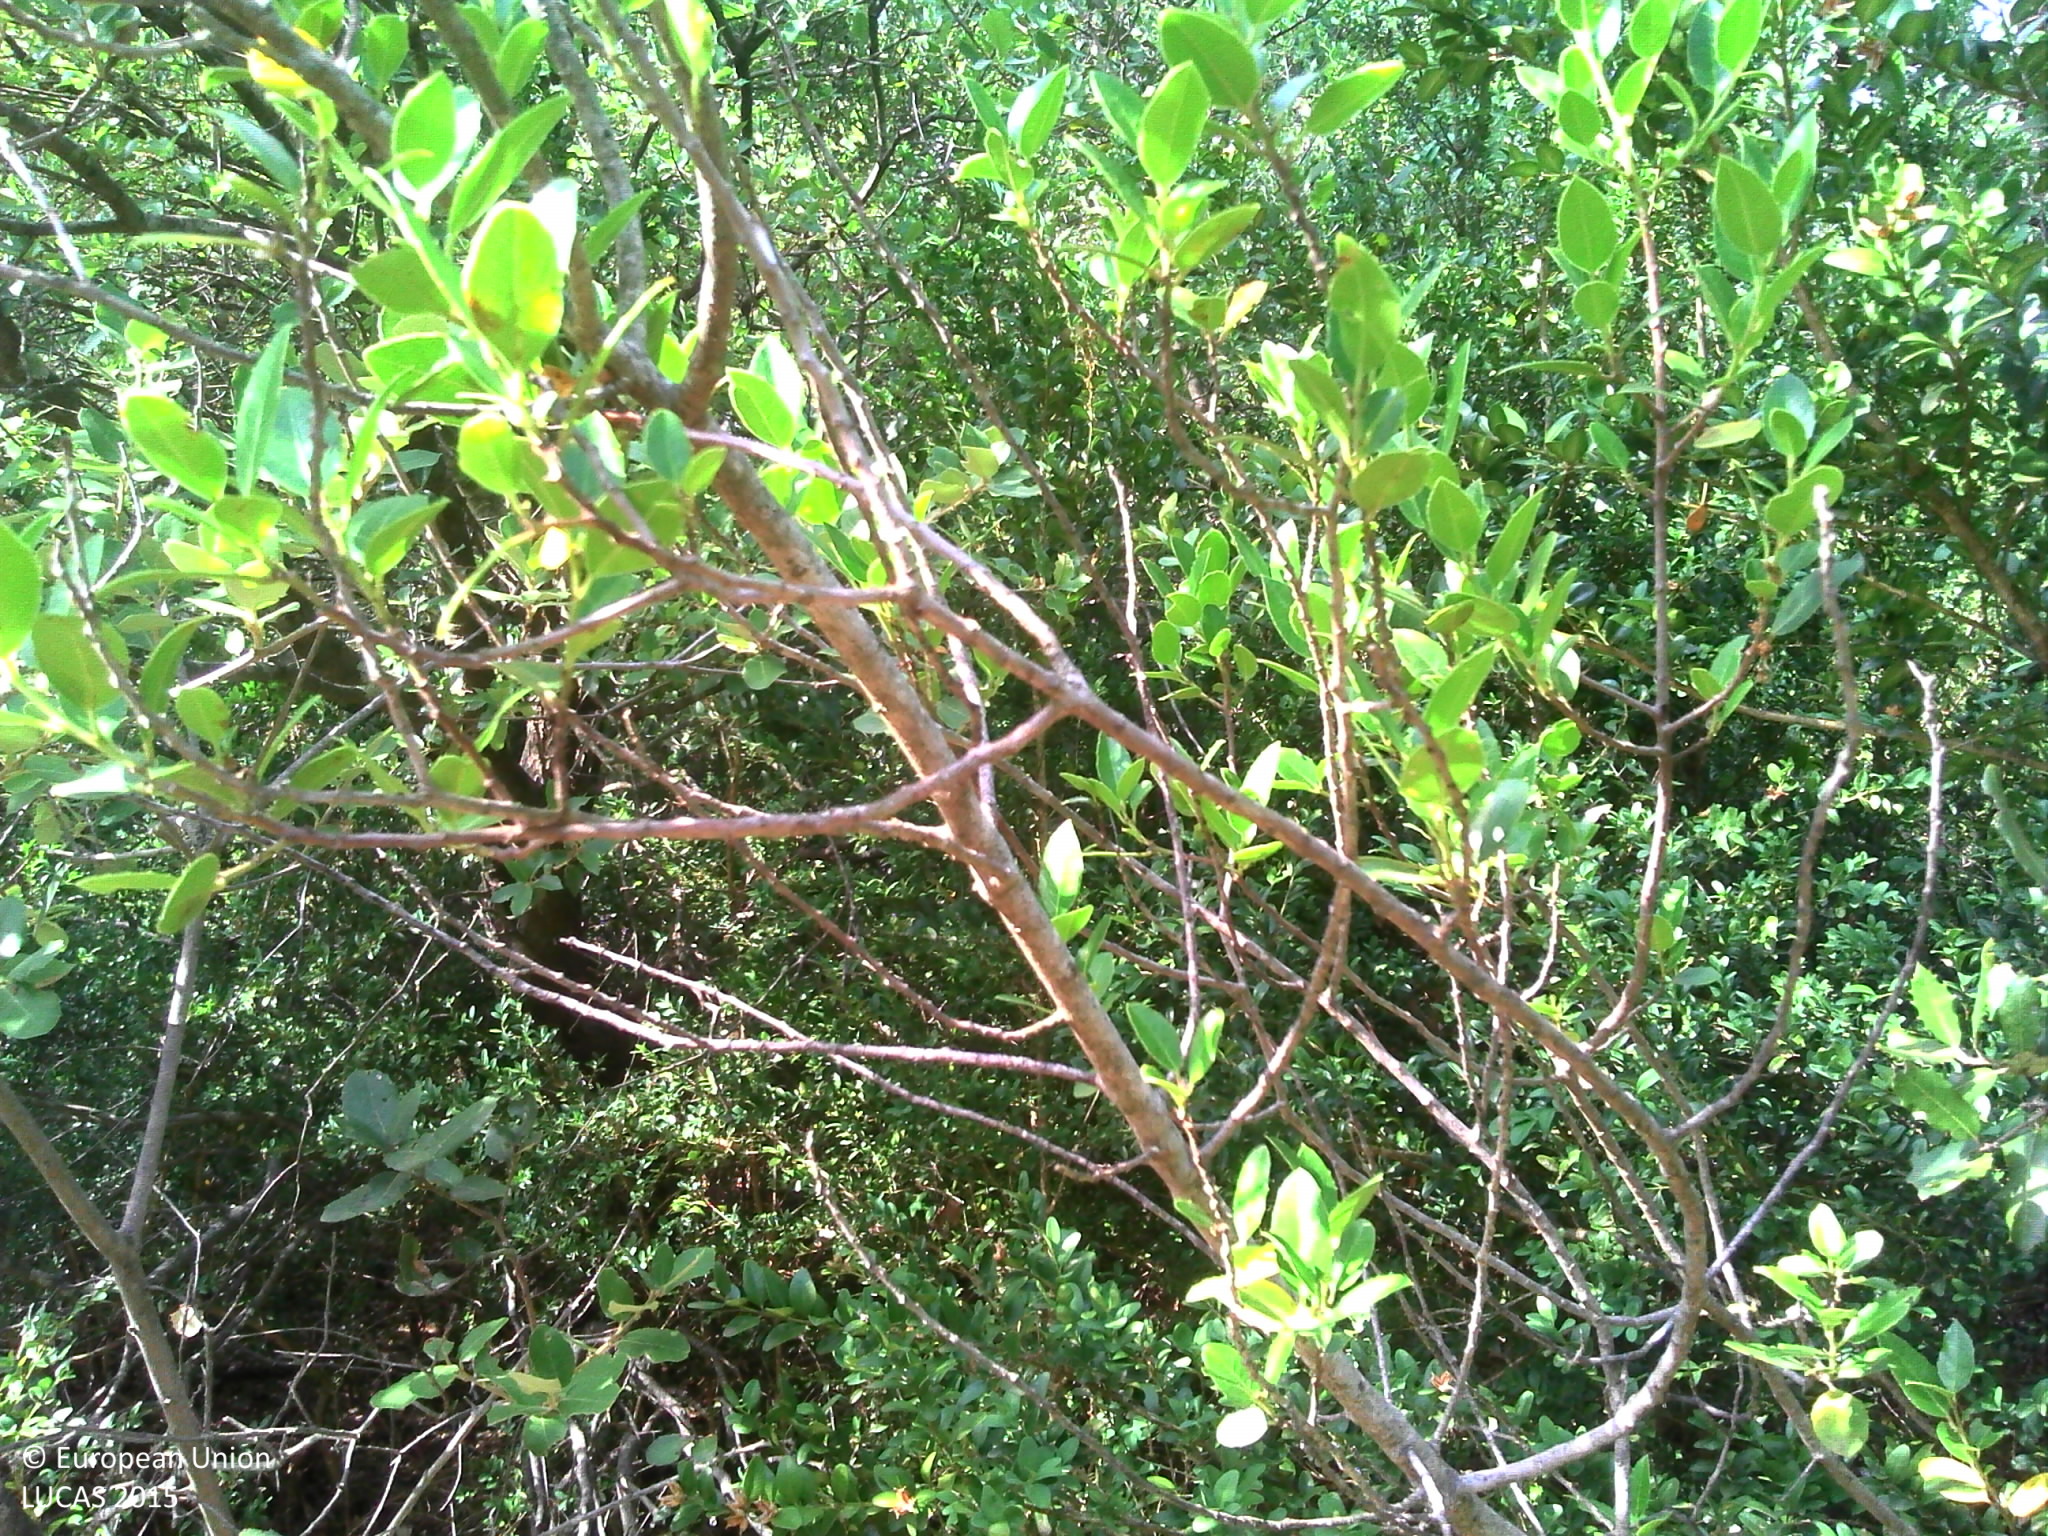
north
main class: Woodland
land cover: Broadleaved woodland
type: thermophilous deciduous forest
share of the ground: > 75 %
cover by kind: broadleaved forest trees 100 %
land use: Forestry
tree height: < 5 m
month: July
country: FR
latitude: 44.4355
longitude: 4.7682
